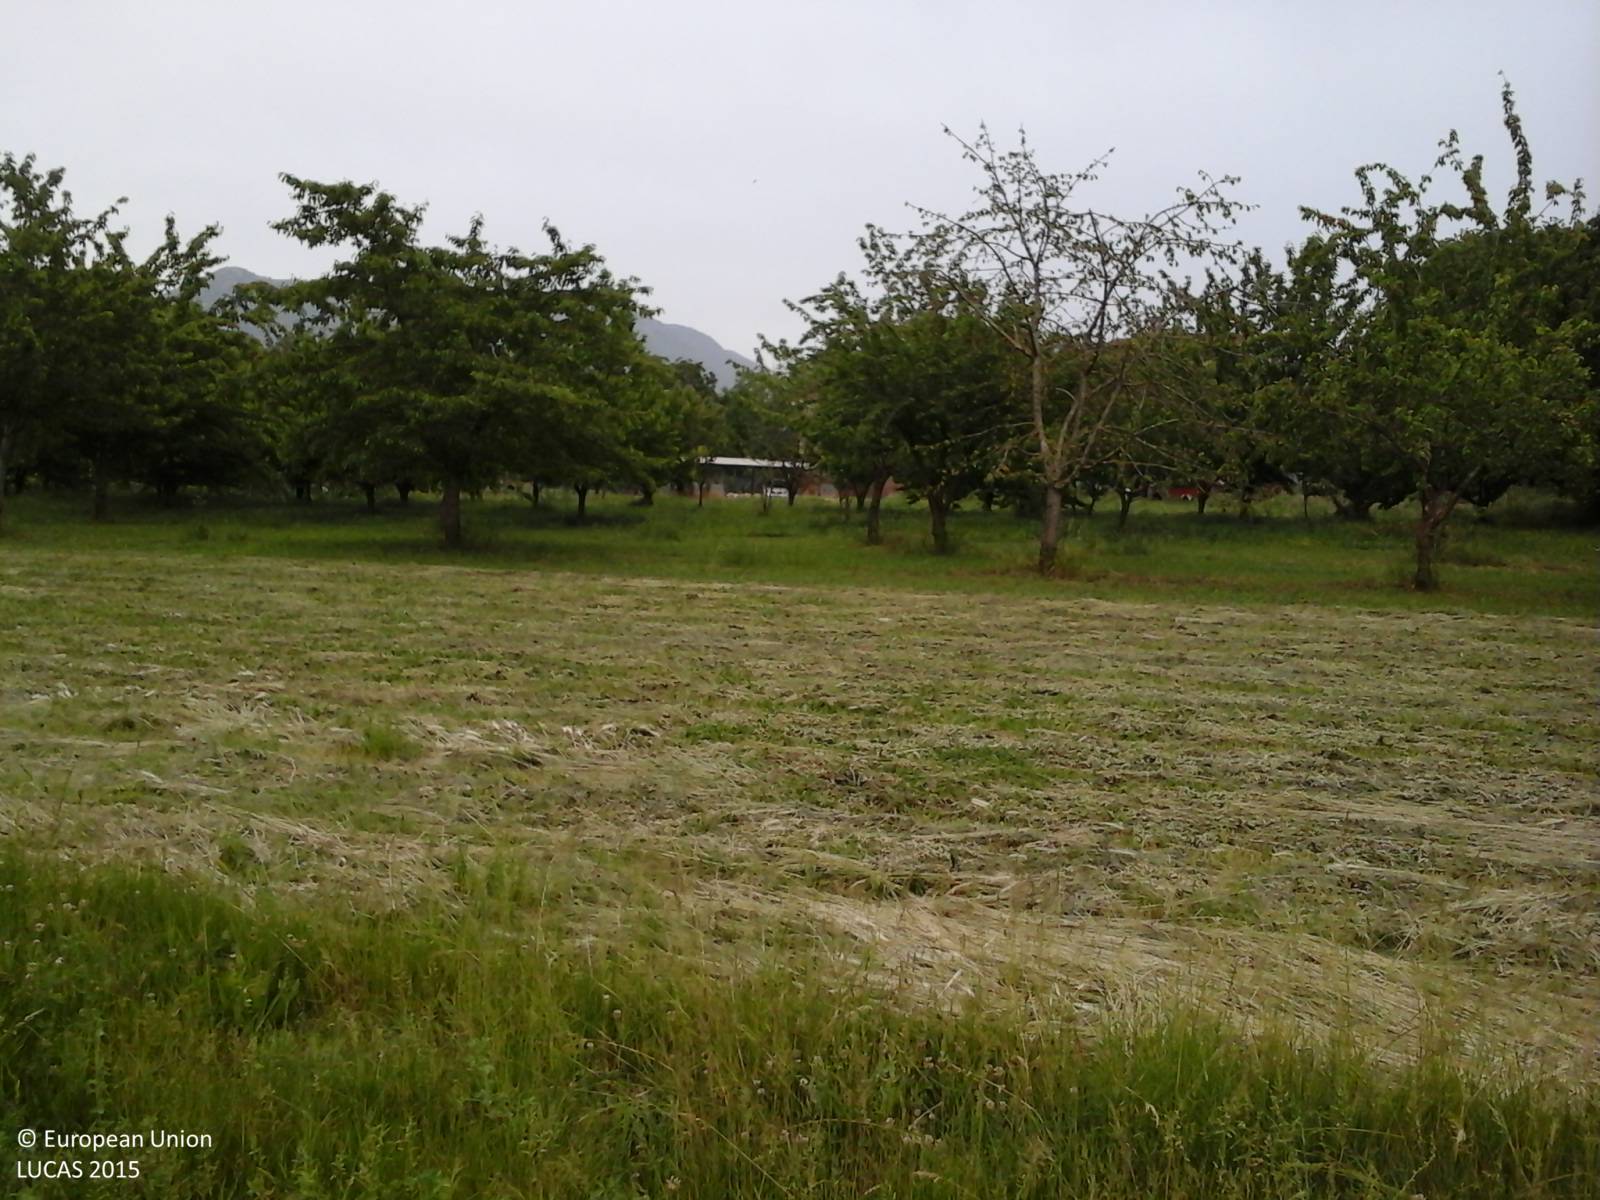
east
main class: Cropland
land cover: Lucerne
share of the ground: > 75 %
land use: Agriculture (excluding fallow land and kitchen gardens)
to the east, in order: Lucerne; Cherry fruit; Other bare soil; Spontaneously vegetated surfaces; Tracks; Spontaneously vegetated surfaces; Fences; Spontaneously vegetated surfaces; Artificial constructions in urban areas; Other fresh vegetables; Broadleaved woodland; Artificial constructions in urban areas; Single bushes/trees; Electric lines; Spontaneously vegetated surfaces; Other fruit trees and berries; Artificial constructions in urban areas
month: May
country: IT
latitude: 41.1447
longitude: 14.4507
